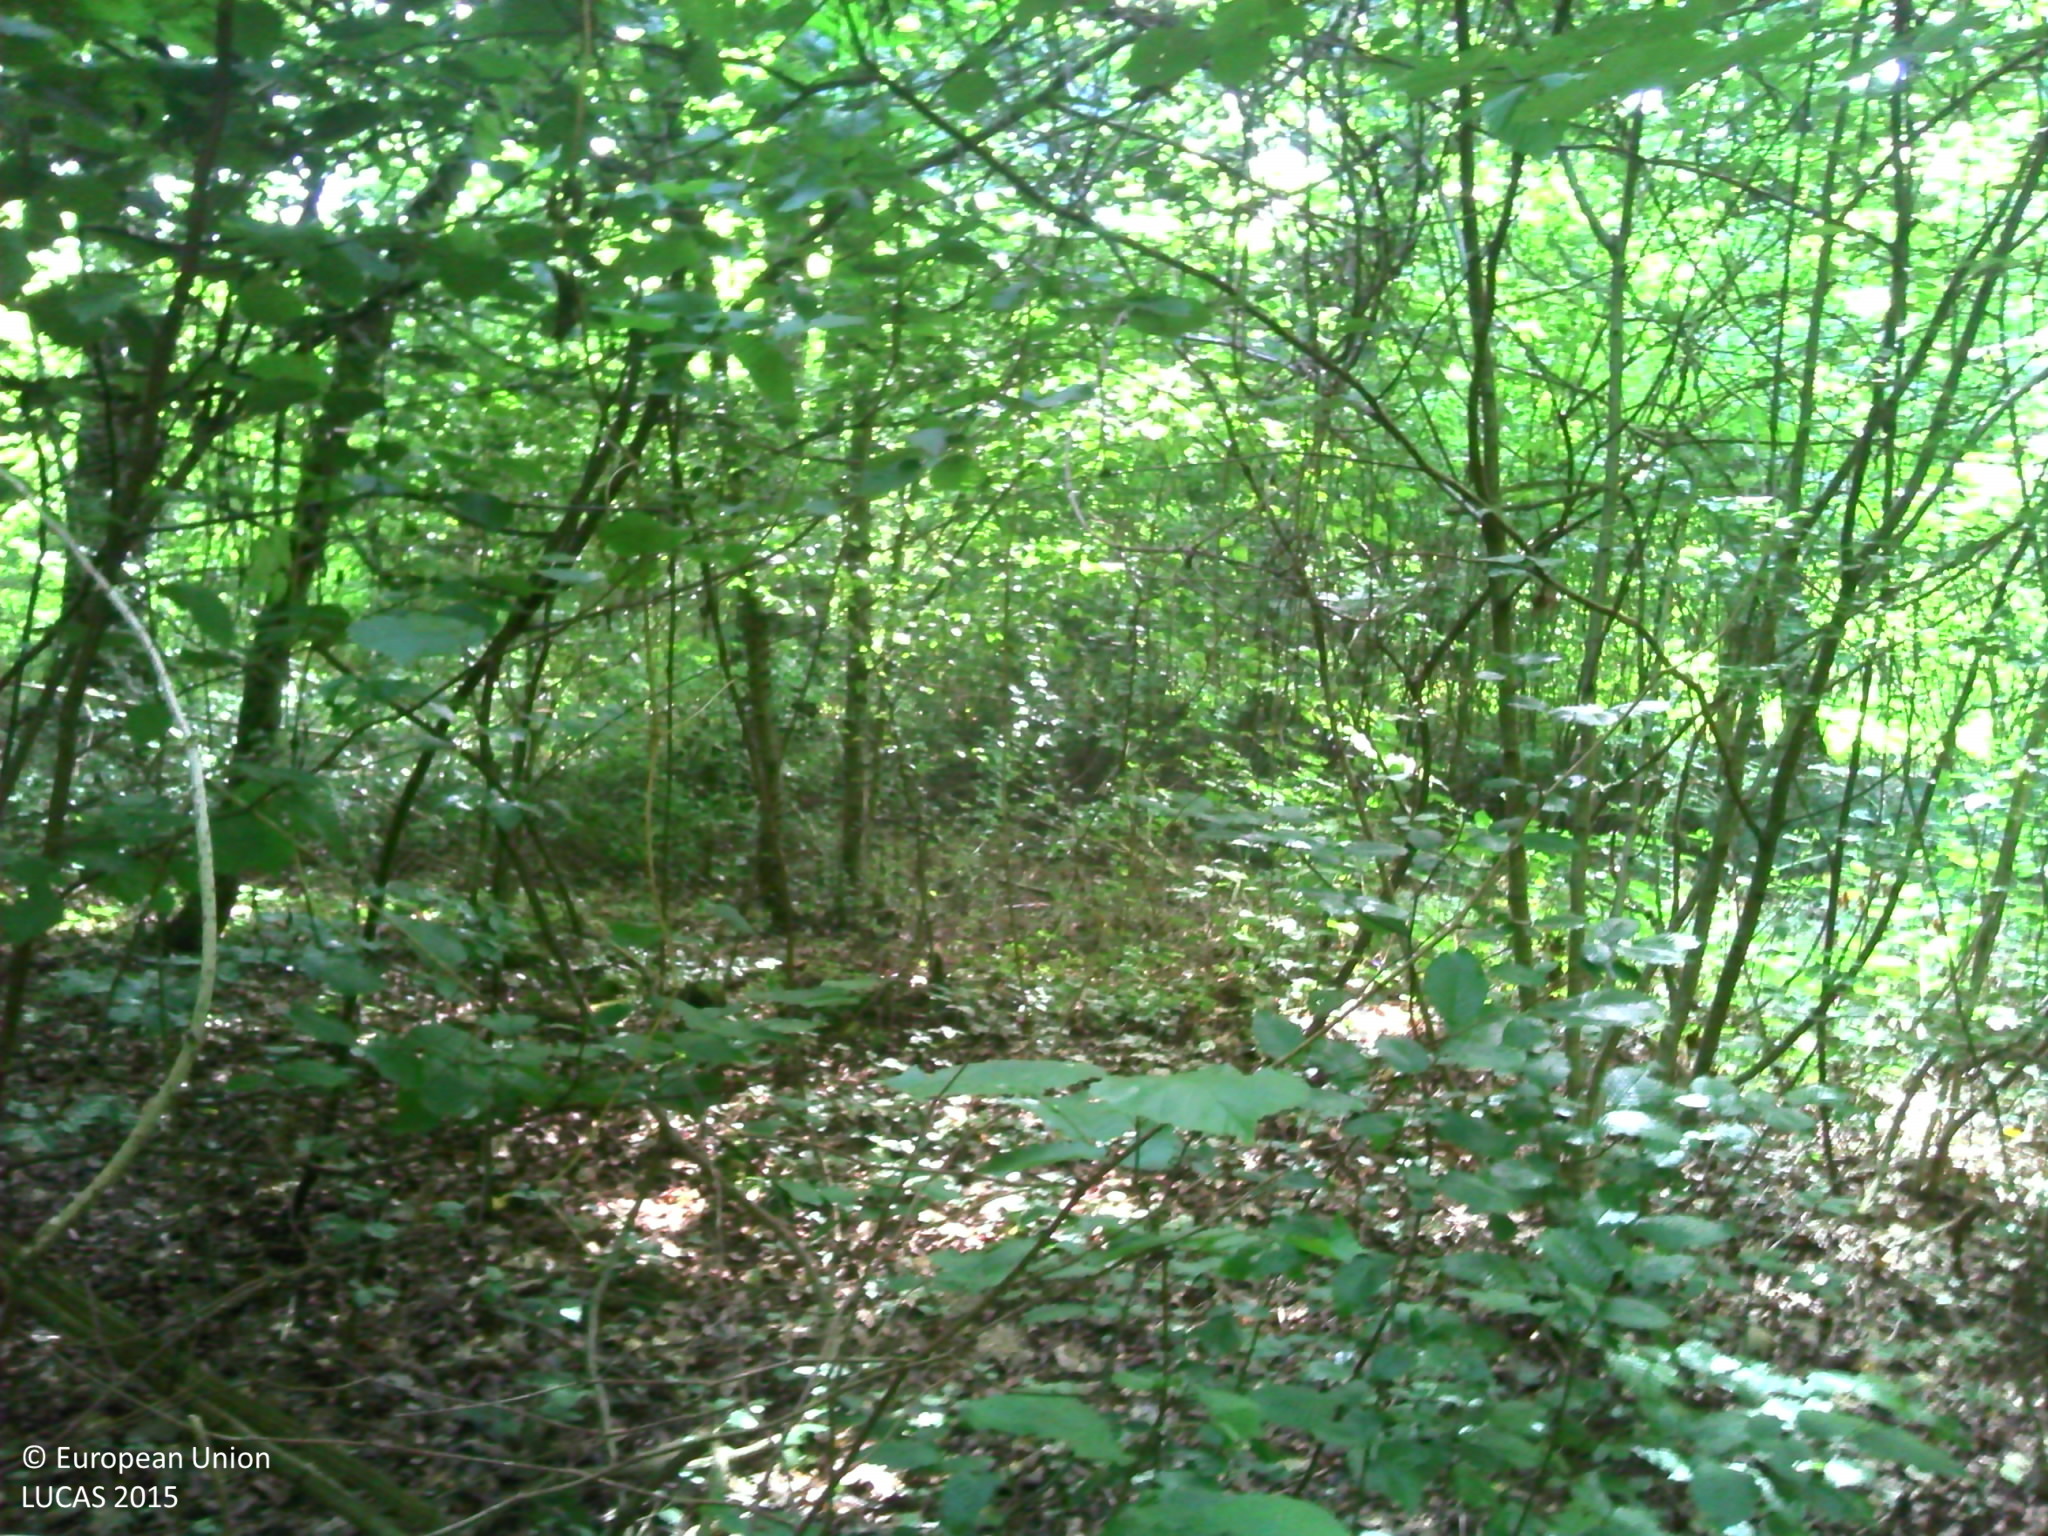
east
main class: Woodland
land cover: Broadleaved woodland
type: mesophytic deciduous forest
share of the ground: > 75 %
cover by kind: broadleaved forest trees 95 %, herbaceous plants 5 %
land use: Forestry
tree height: > 5 m
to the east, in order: Broadleaved woodland; Tracks; Broadleaved woodland
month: August
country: FR
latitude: 49.5452
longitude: 5.2575
